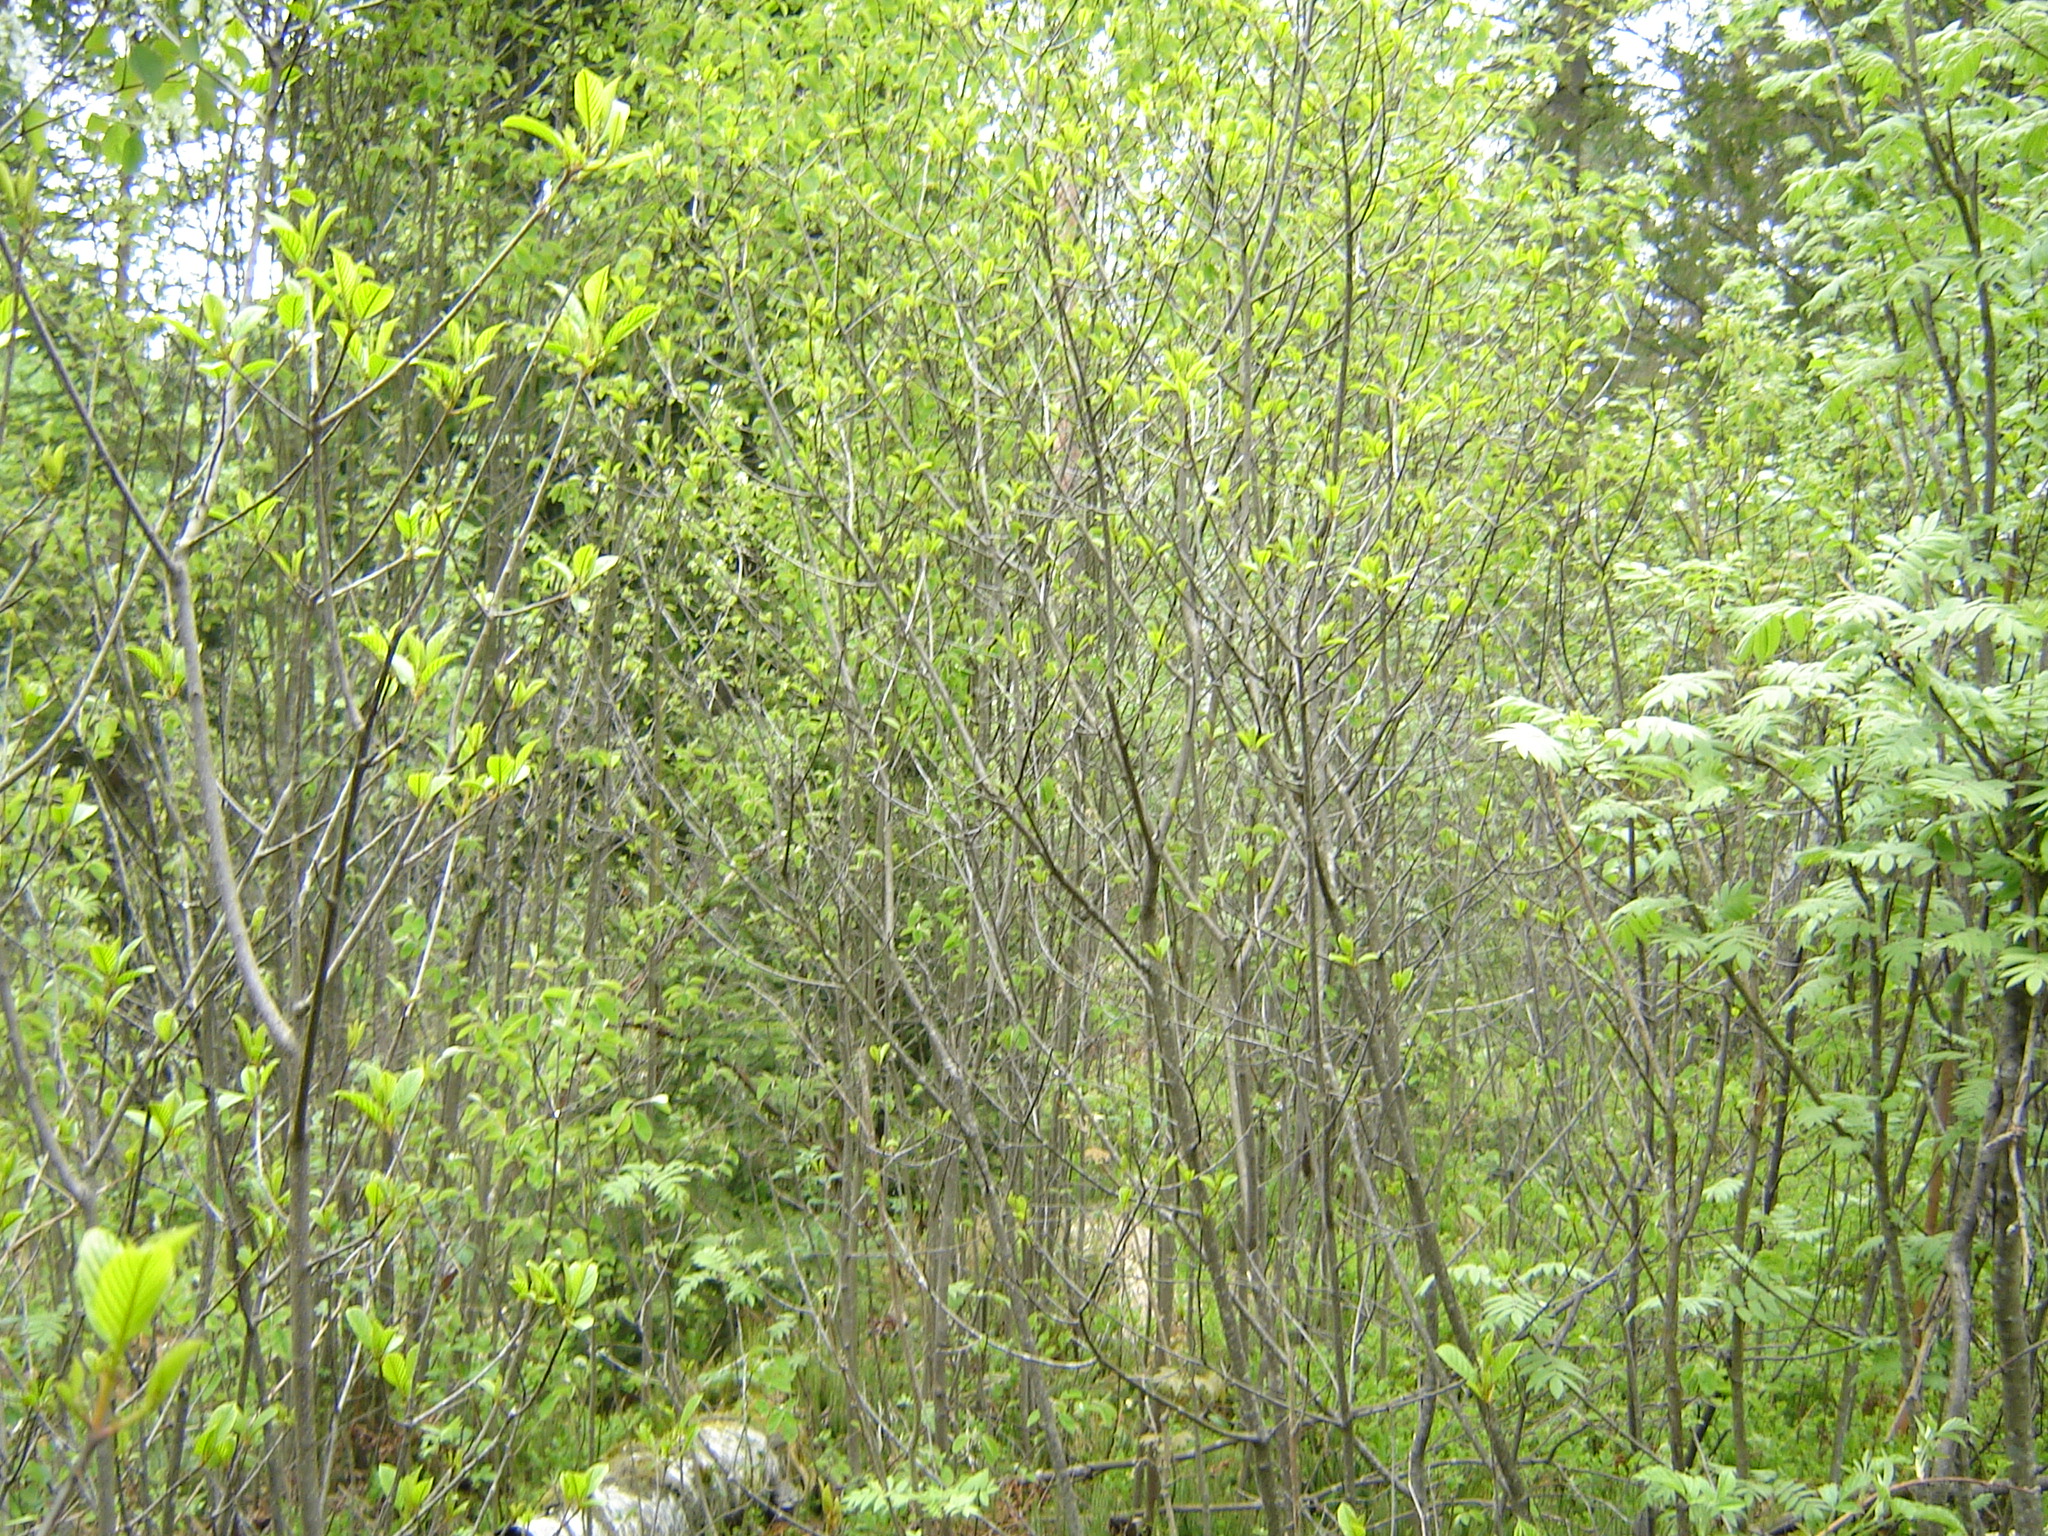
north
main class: Woodland
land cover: Other mixed woodland
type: hemiboreal forest and nemoral coniferous forest and mixed broadleaved-coniferous forest
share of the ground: > 75 %
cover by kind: coniferous forest trees 50 %, broadleaved forest trees 50 %
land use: Forestry
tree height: > 5 m
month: May
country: LT
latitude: 56.1221
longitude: 25.3181
